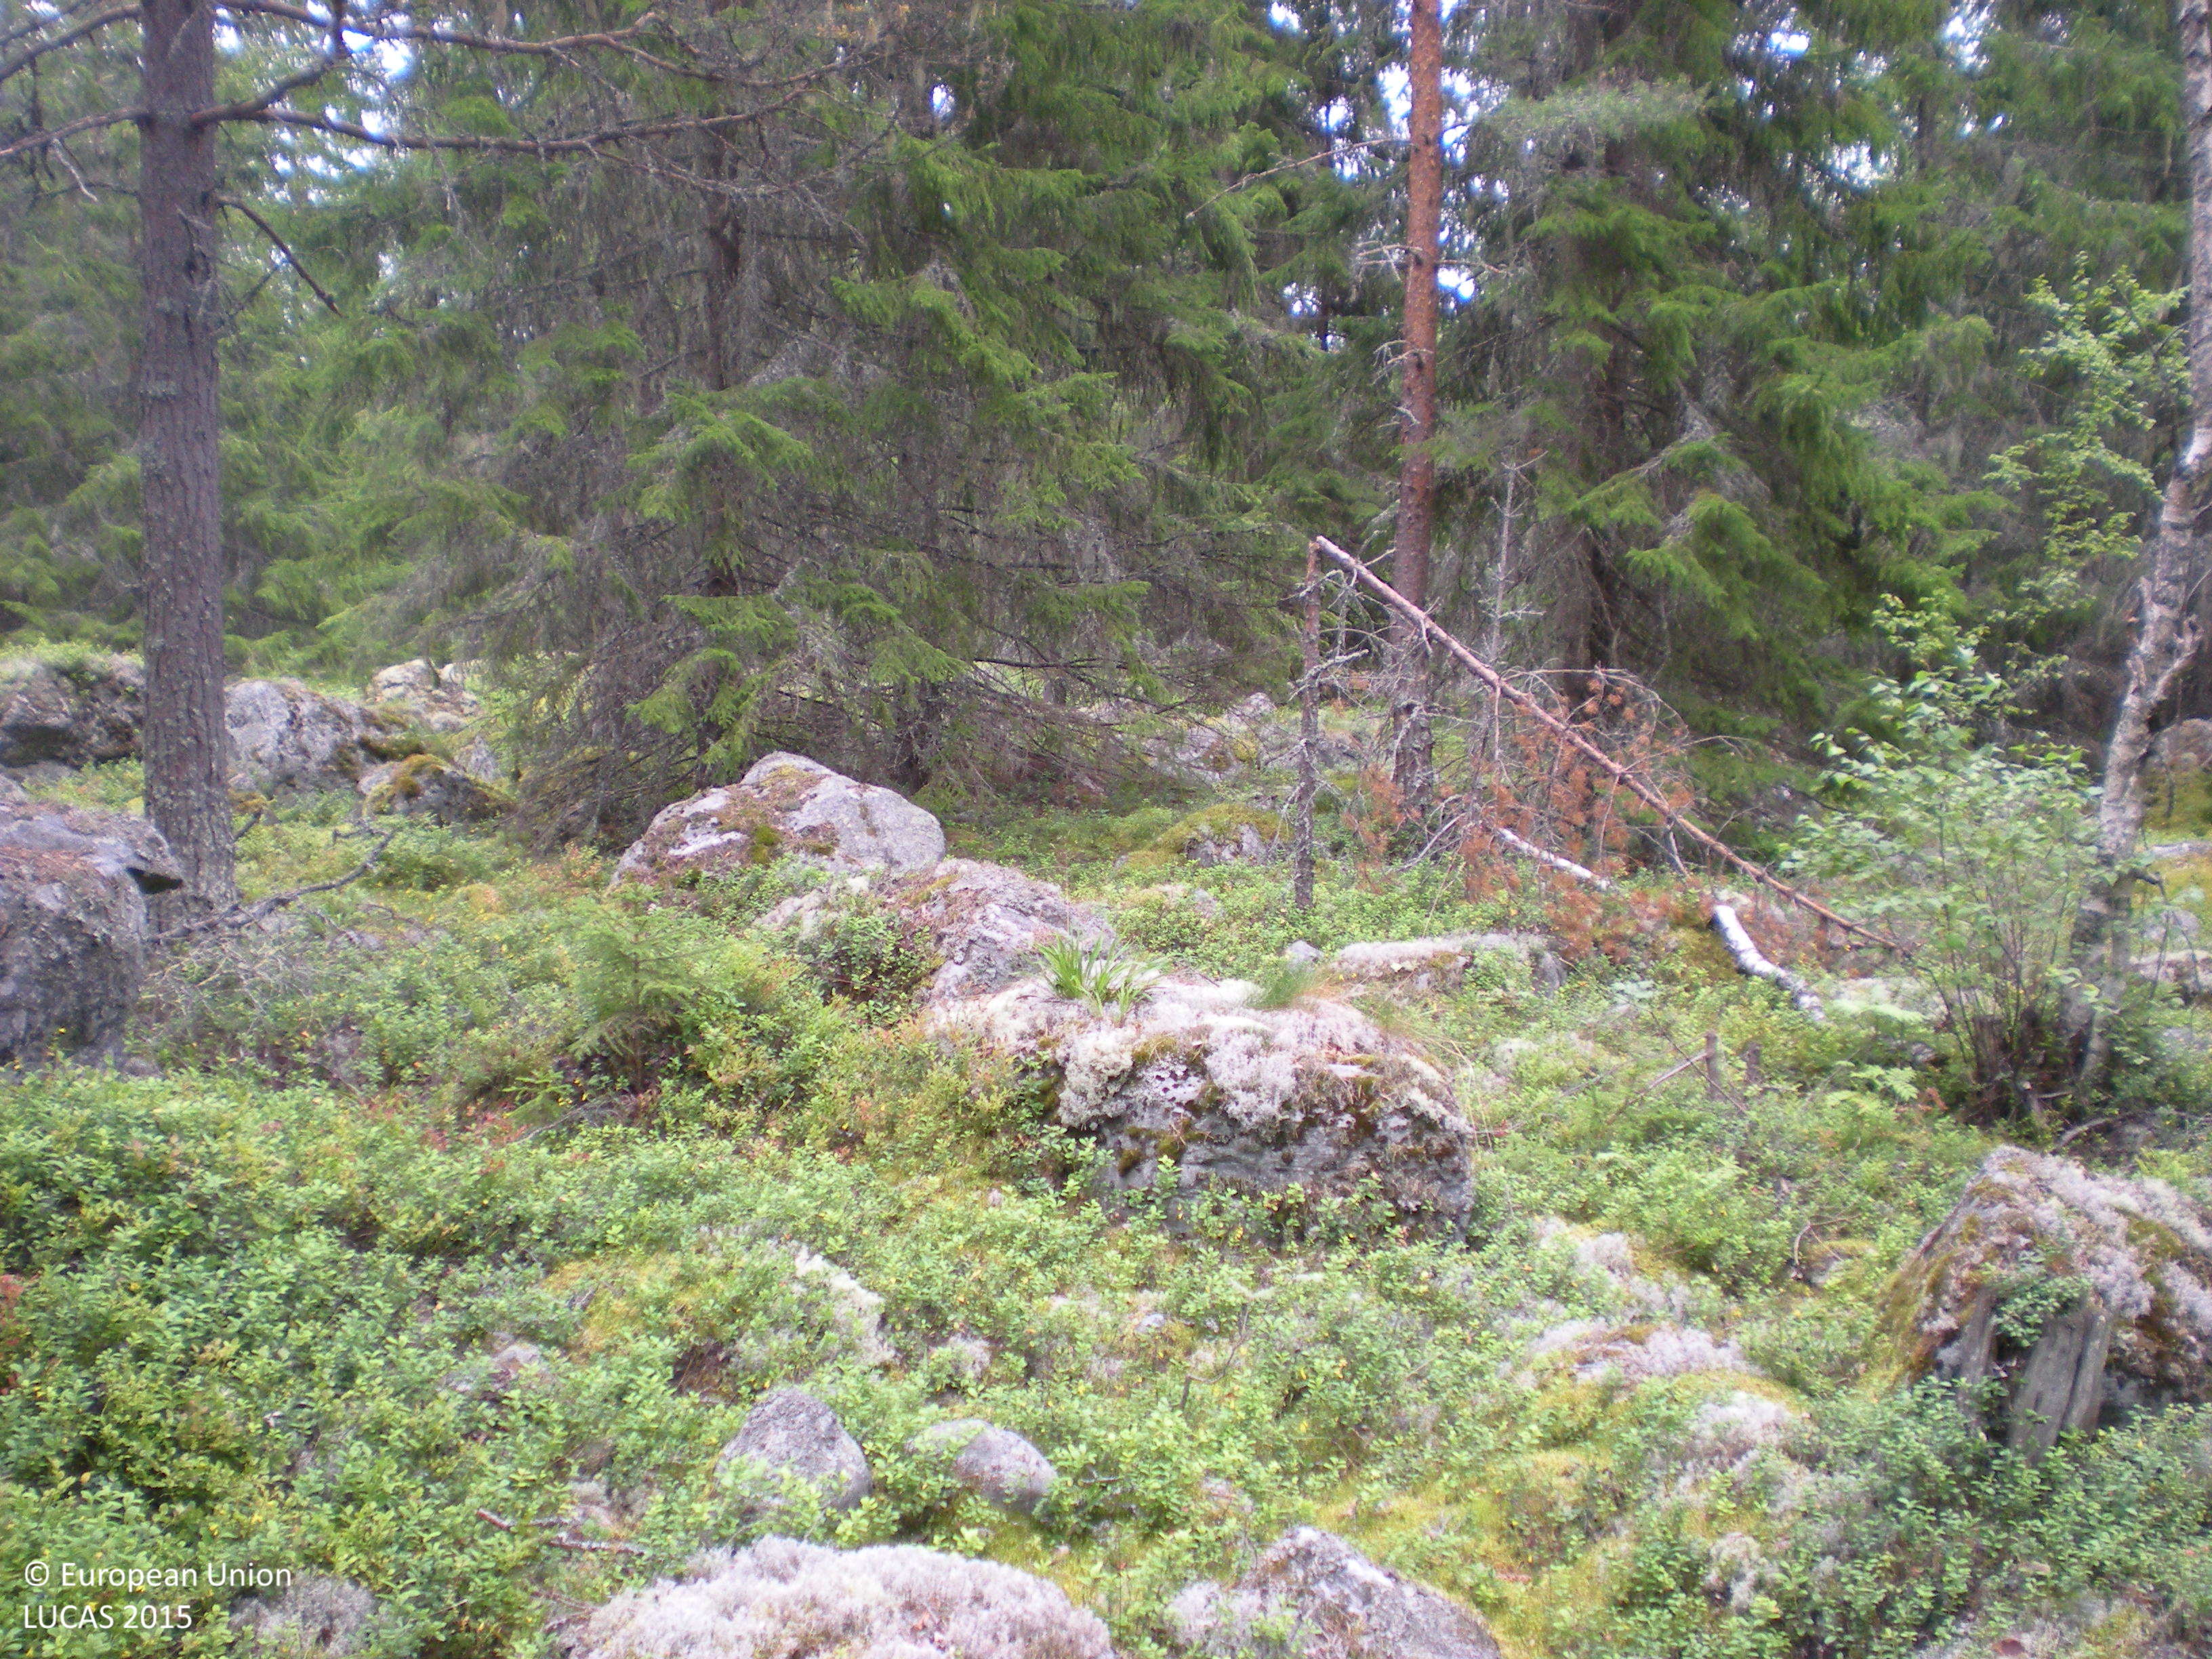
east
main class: Woodland
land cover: Other coniferous woodland
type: boreal forest
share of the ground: 50 - 75 %
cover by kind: coniferous forest trees 65 %, consolidated bare surface 15 %, shrubs 10 %, herbaceous plants 5 %, lichens and mosses 5 %
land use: Forestry
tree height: > 5 m
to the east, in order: Other coniferous woodland; Spruce dominated coniferous woodland; Other coniferous woodland; Pine dominated coniferous woodland; Spruce dominated mixed woodland
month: August
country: SE
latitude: 60.8119
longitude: 17.1760
